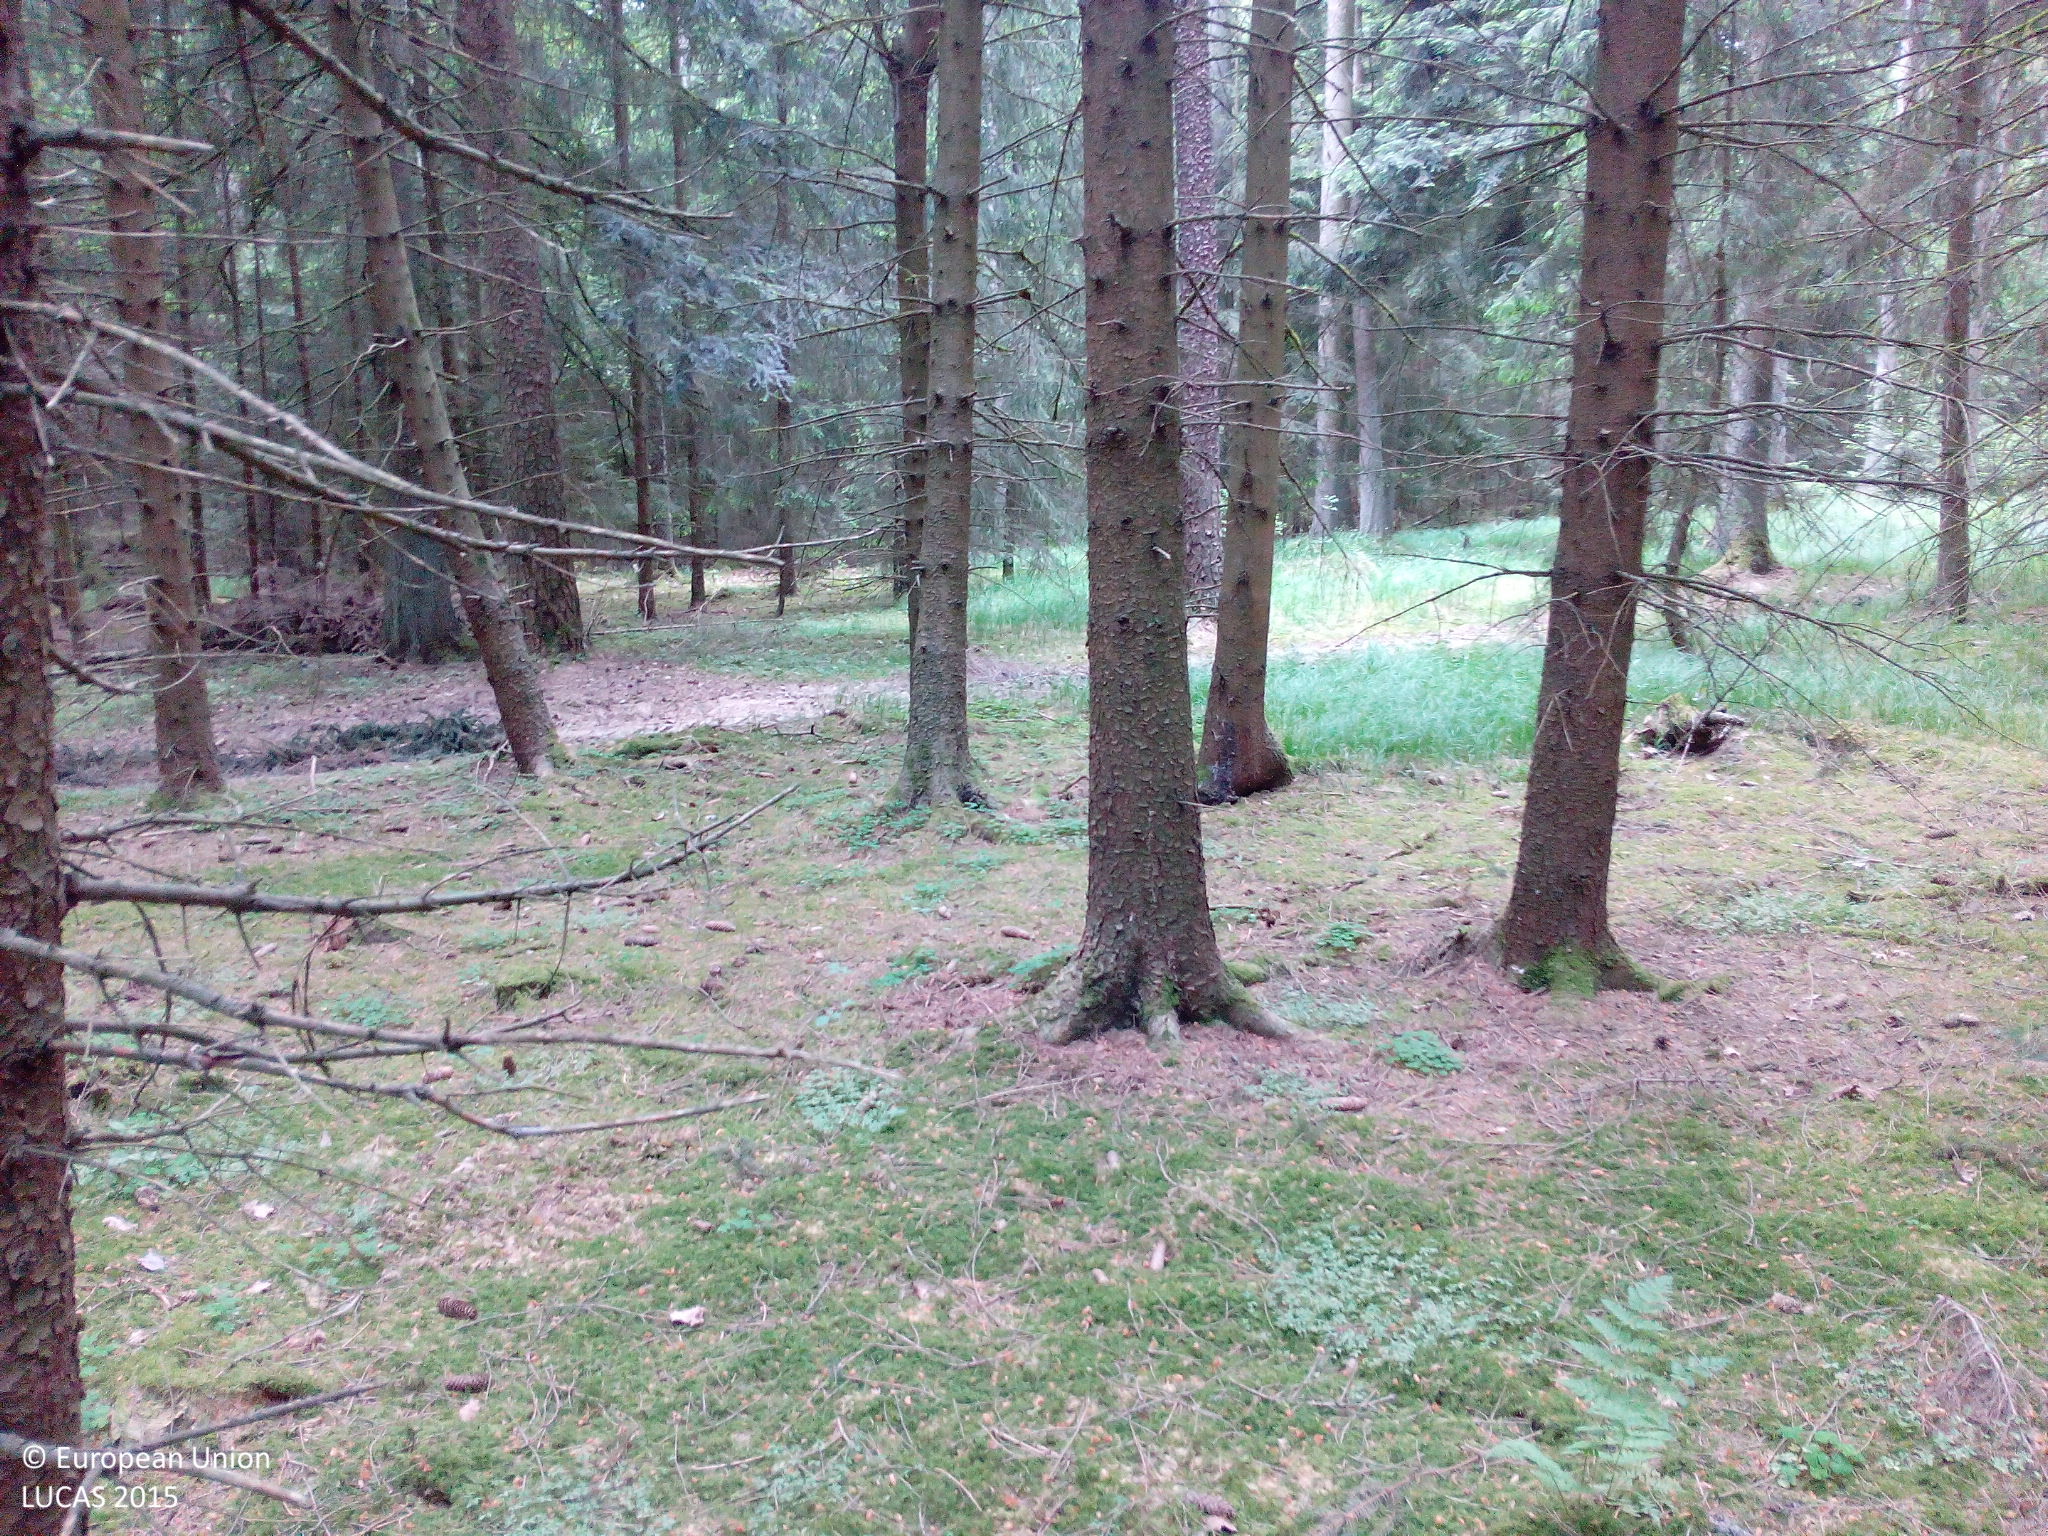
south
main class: Woodland
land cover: Spruce dominated coniferous woodland
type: hemiboreal forest and nemoral coniferous forest and mixed broadleaved-coniferous forest
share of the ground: > 75 %
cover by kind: coniferous forest trees 80 %, herbaceous plants 20 %
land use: Forestry
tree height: > 5 m
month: May
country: DE
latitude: 49.1408
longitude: 10.2603
